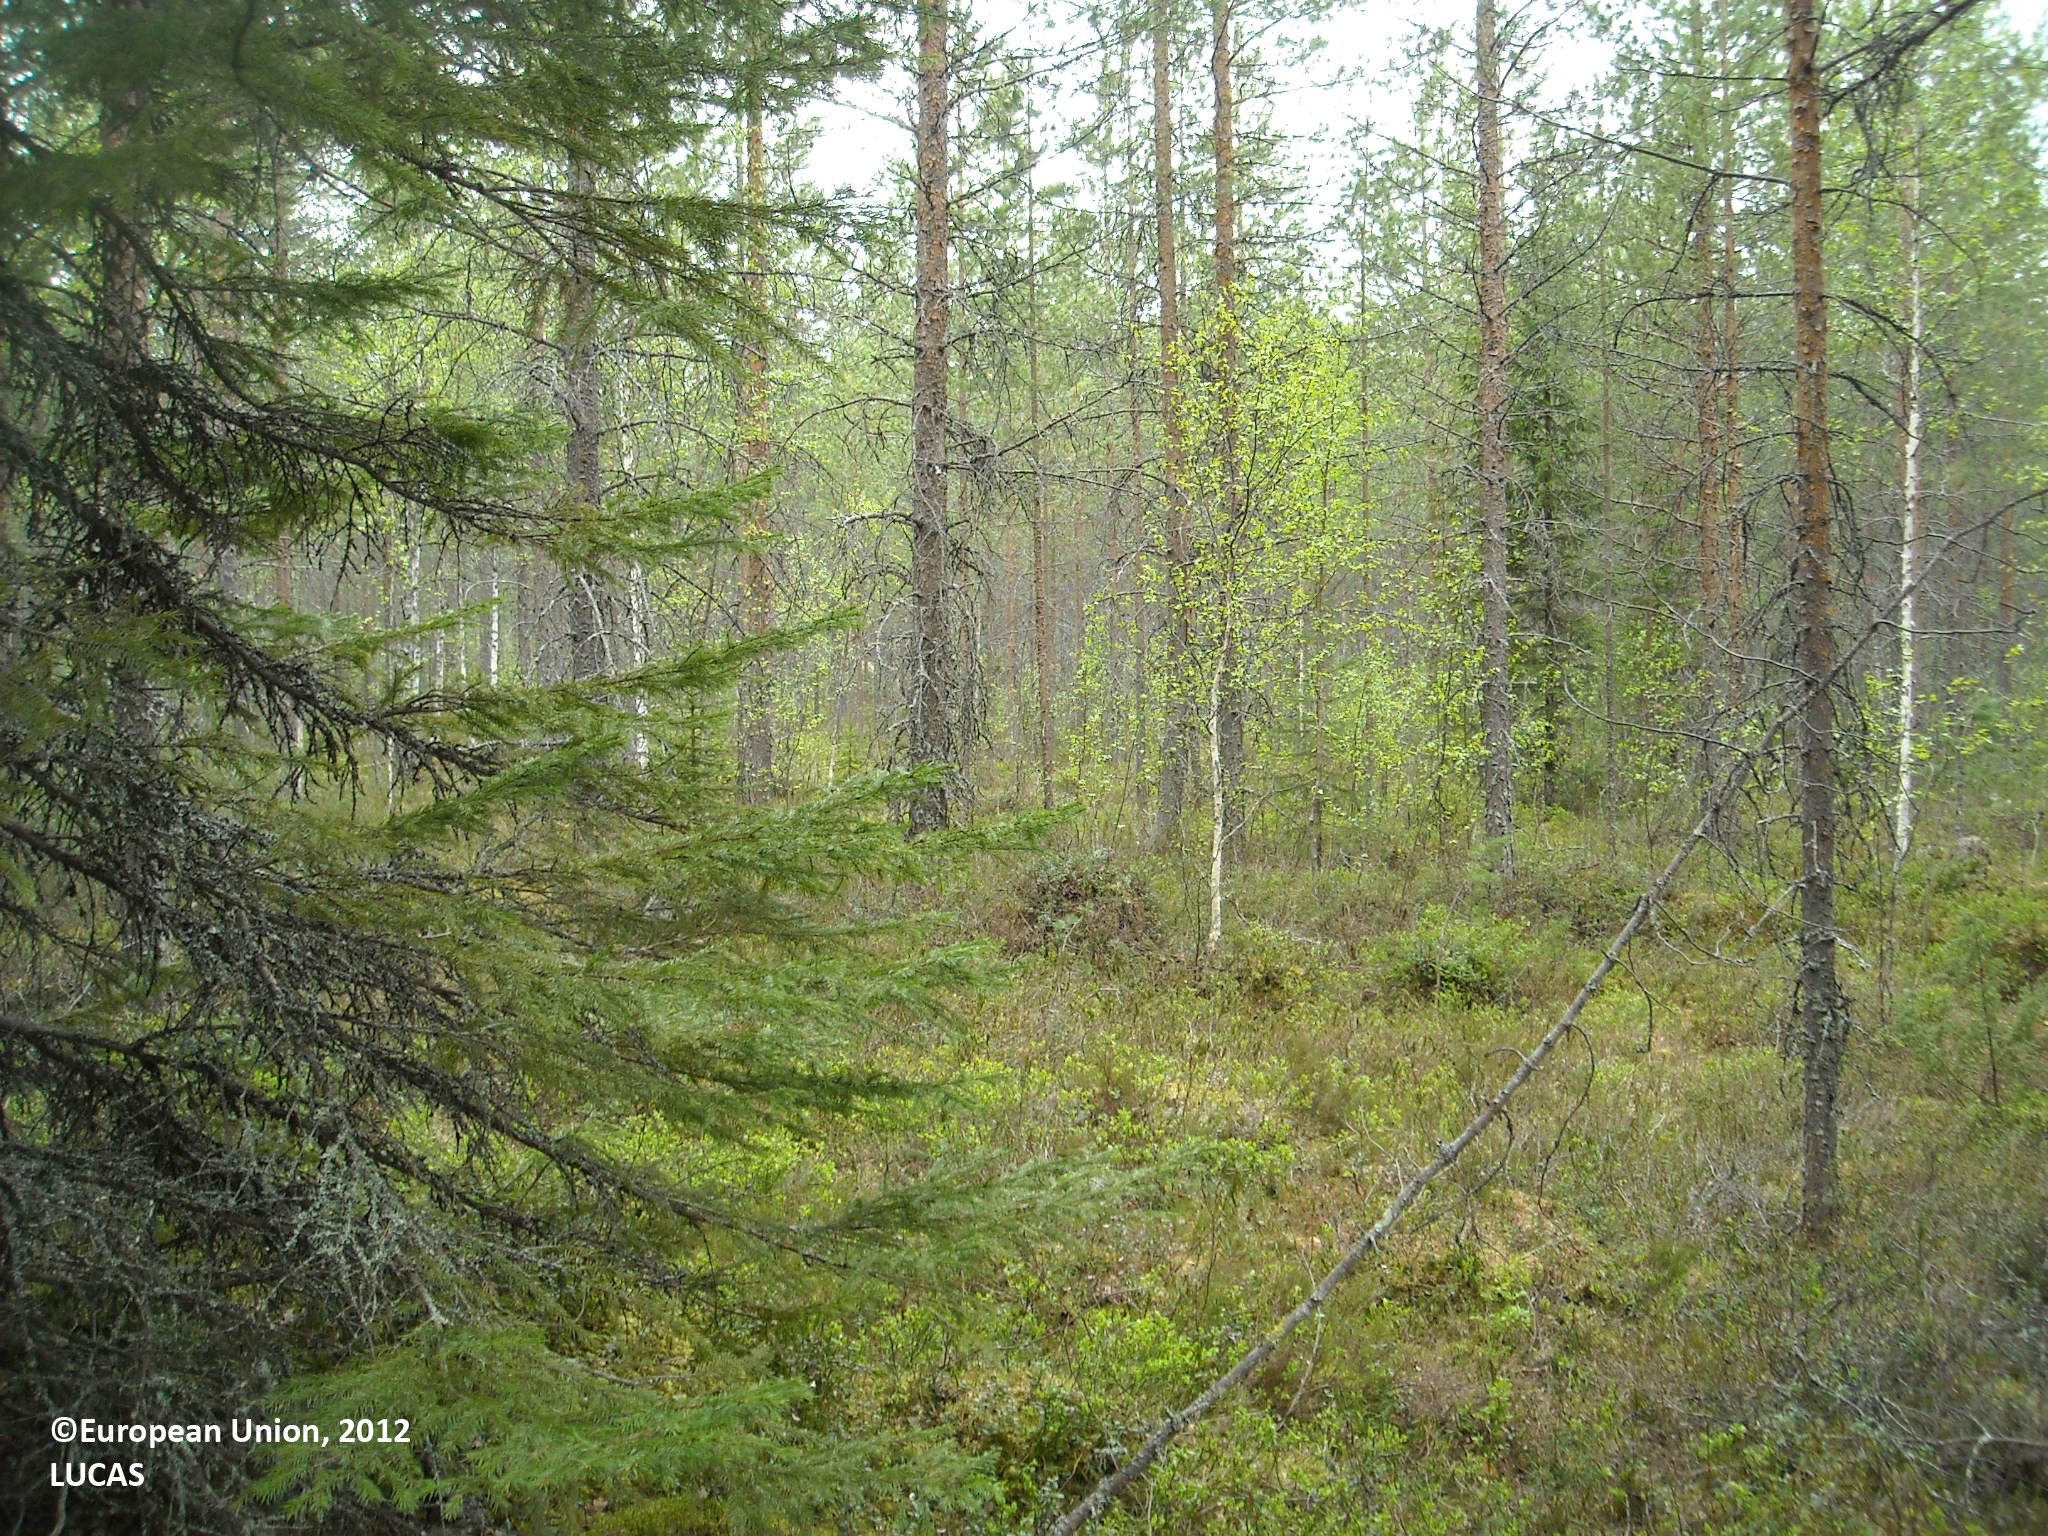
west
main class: Woodland
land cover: Pine dominated coniferous woodland
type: boreal forest
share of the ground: > 75 %
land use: Forestry
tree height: > 5 m
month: June
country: FI
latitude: 64.6517
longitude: 27.4094
